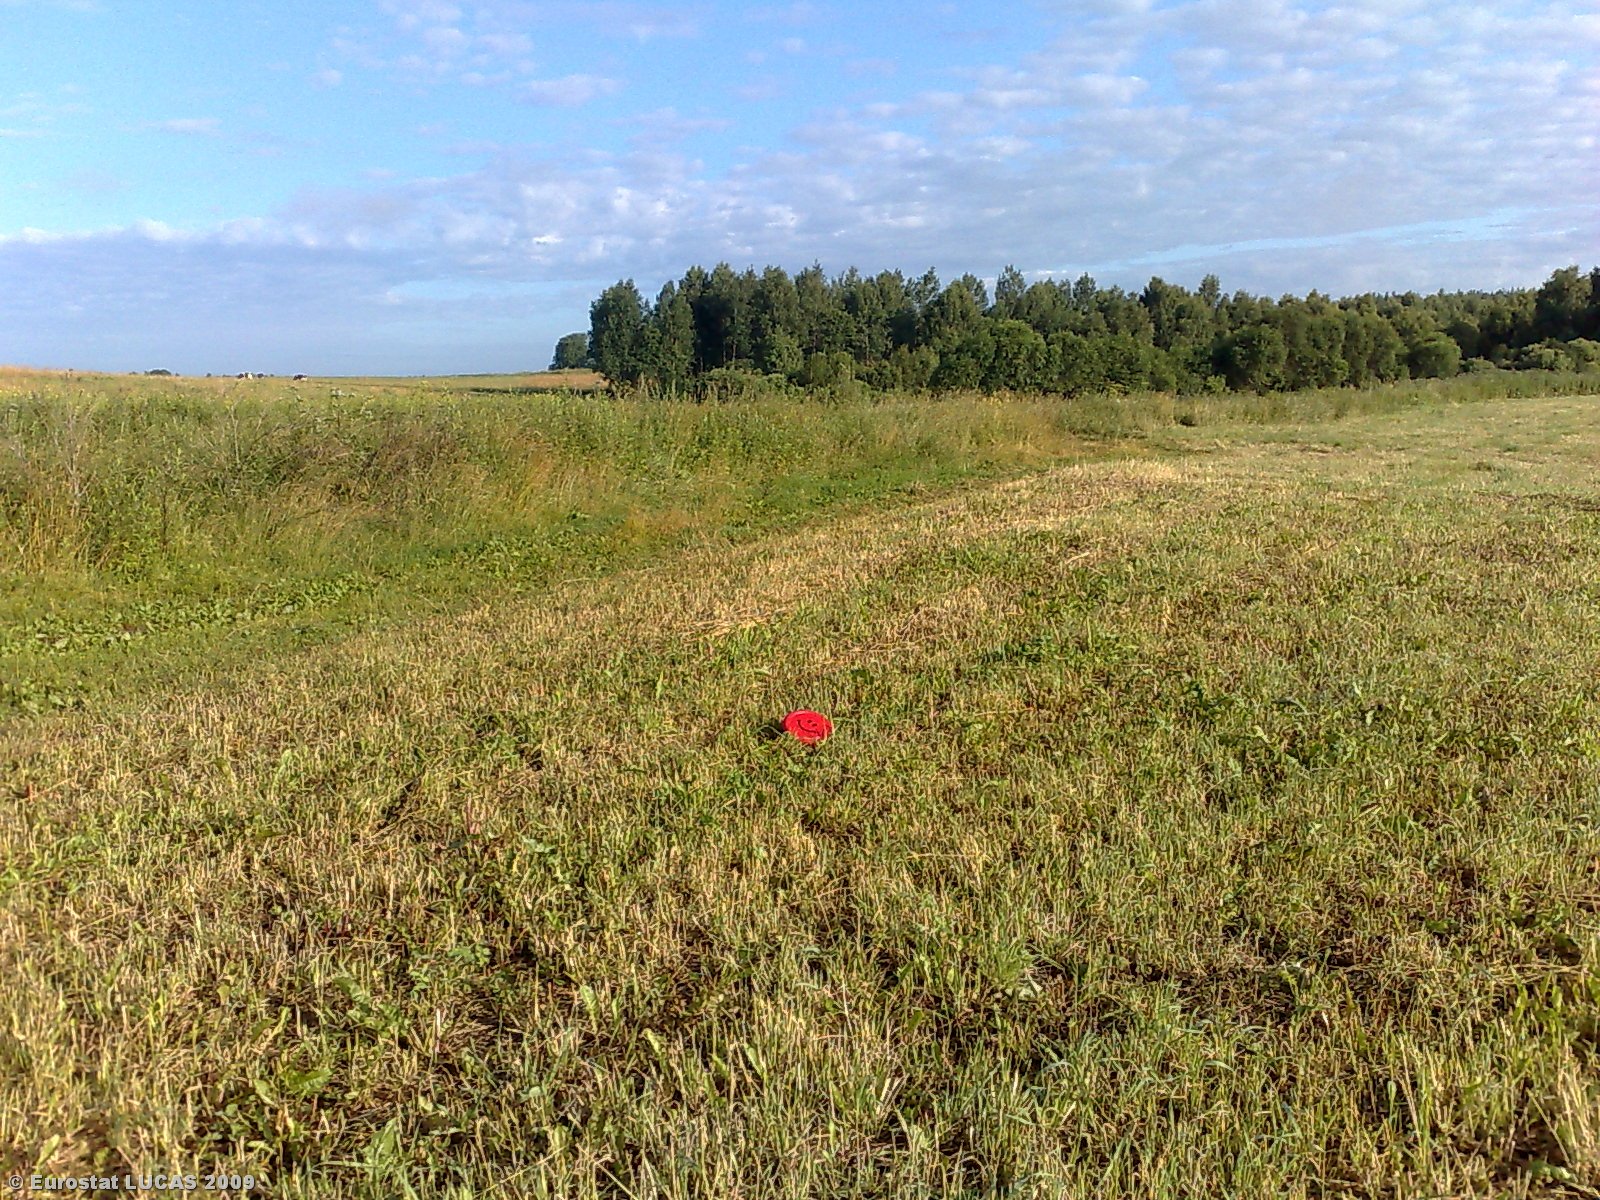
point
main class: Grassland
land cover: Grassland without tree/shrub cover
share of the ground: > 75 %
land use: Agriculture (excluding fallow land and kitchen gardens)
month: July
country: LT
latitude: 55.6708
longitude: 22.8012
